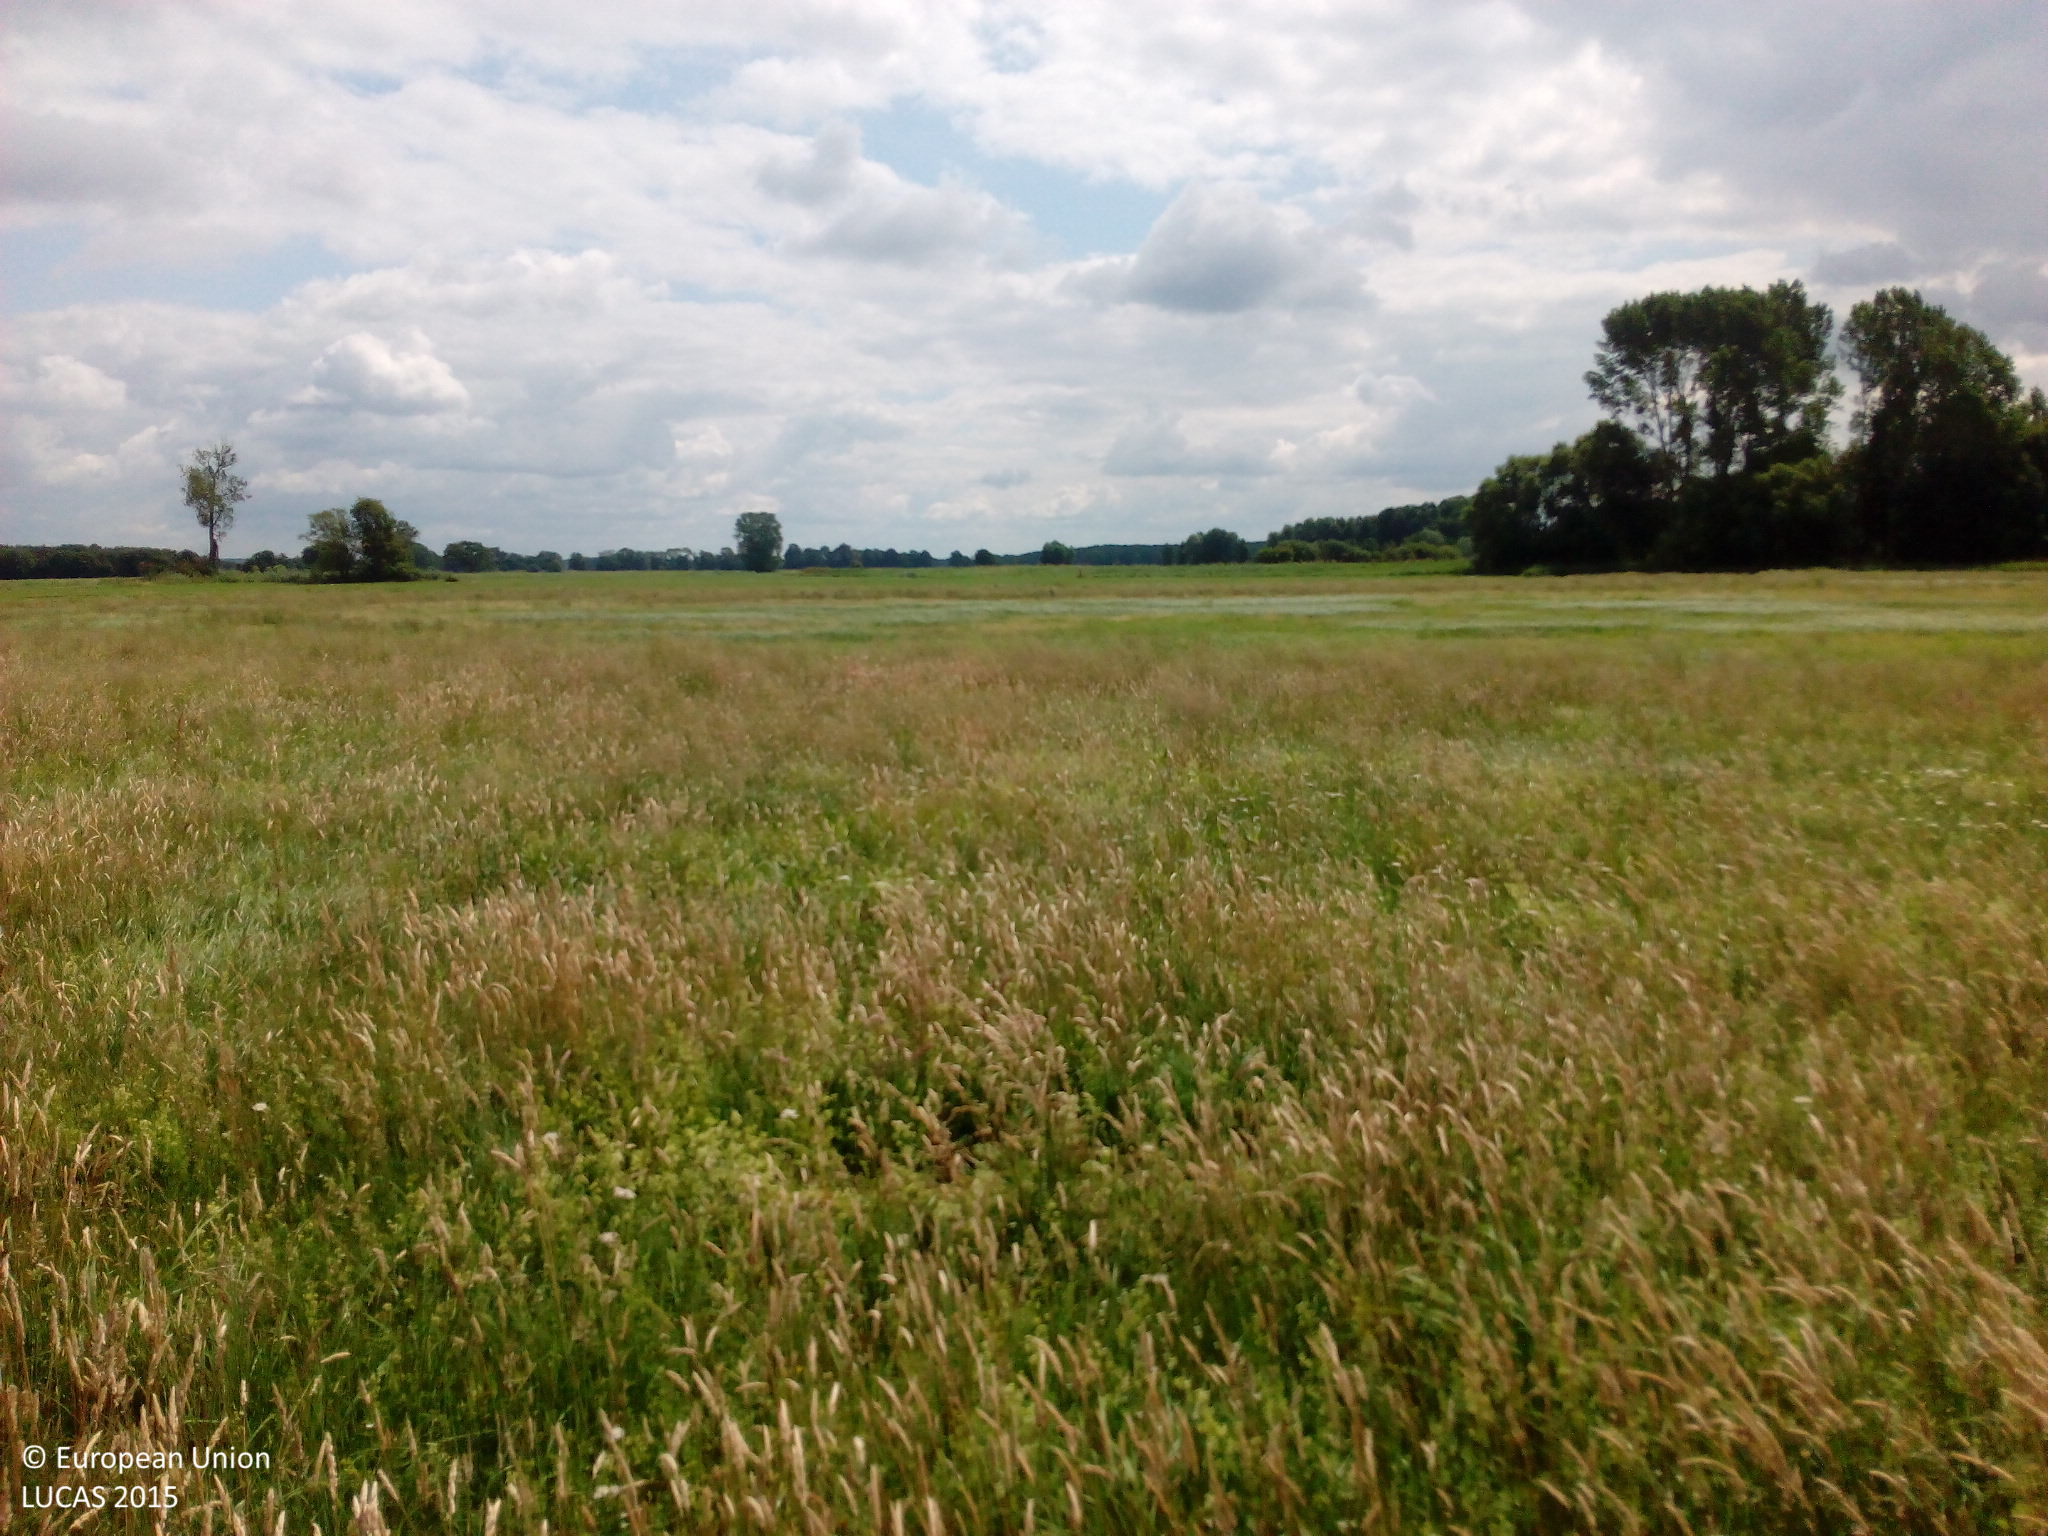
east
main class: Grassland
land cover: Grassland without tree/shrub cover
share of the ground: > 75 %
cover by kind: herbaceous plants 100 %
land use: Agriculture (excluding fallow land and kitchen gardens)
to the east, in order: Grassland without tree/shrub cover; Inland fresh running water; Grassland without tree/shrub cover
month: July
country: DE
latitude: 52.6941
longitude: 12.4409
